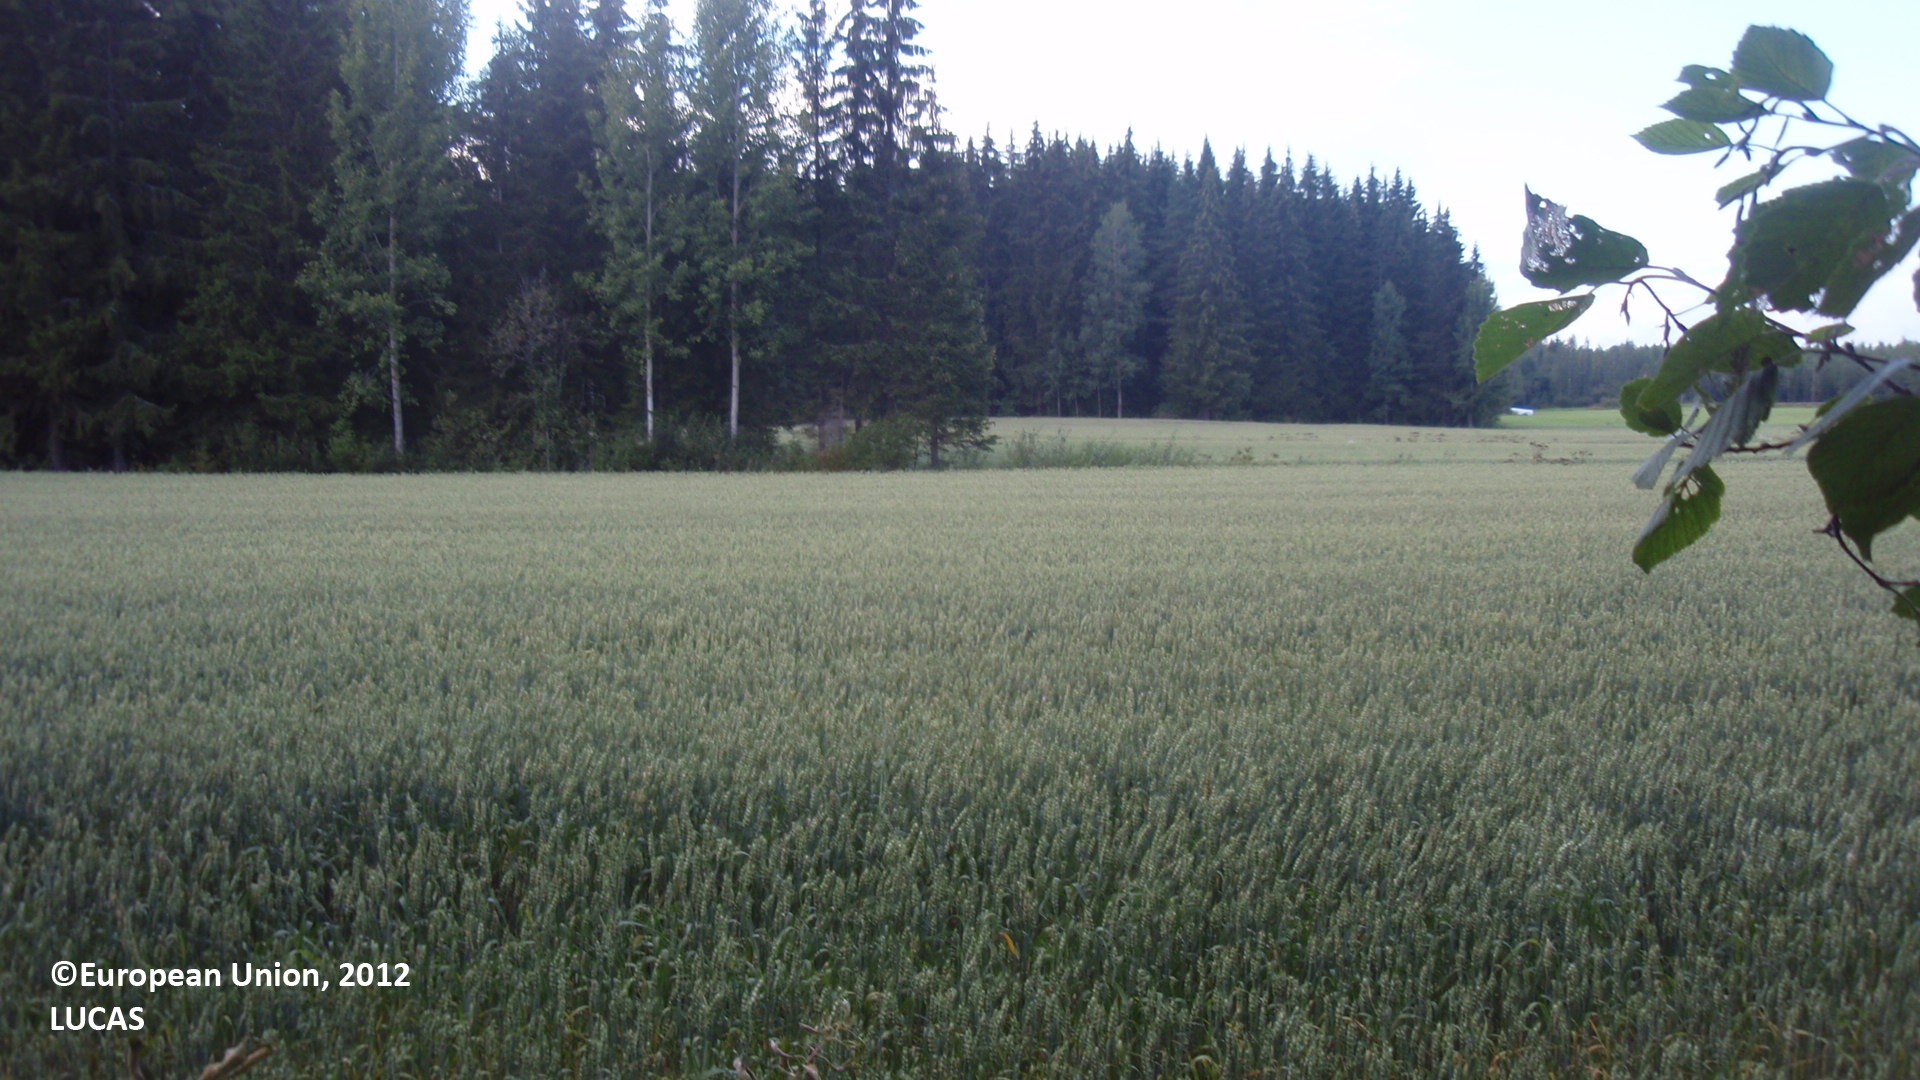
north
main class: Woodland
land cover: Broadleaved woodland
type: non-riverine alder, birch or aspen forest
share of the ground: > 75 %
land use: Forestry
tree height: > 5 m
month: August
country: FI
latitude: 60.6716
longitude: 26.6870
